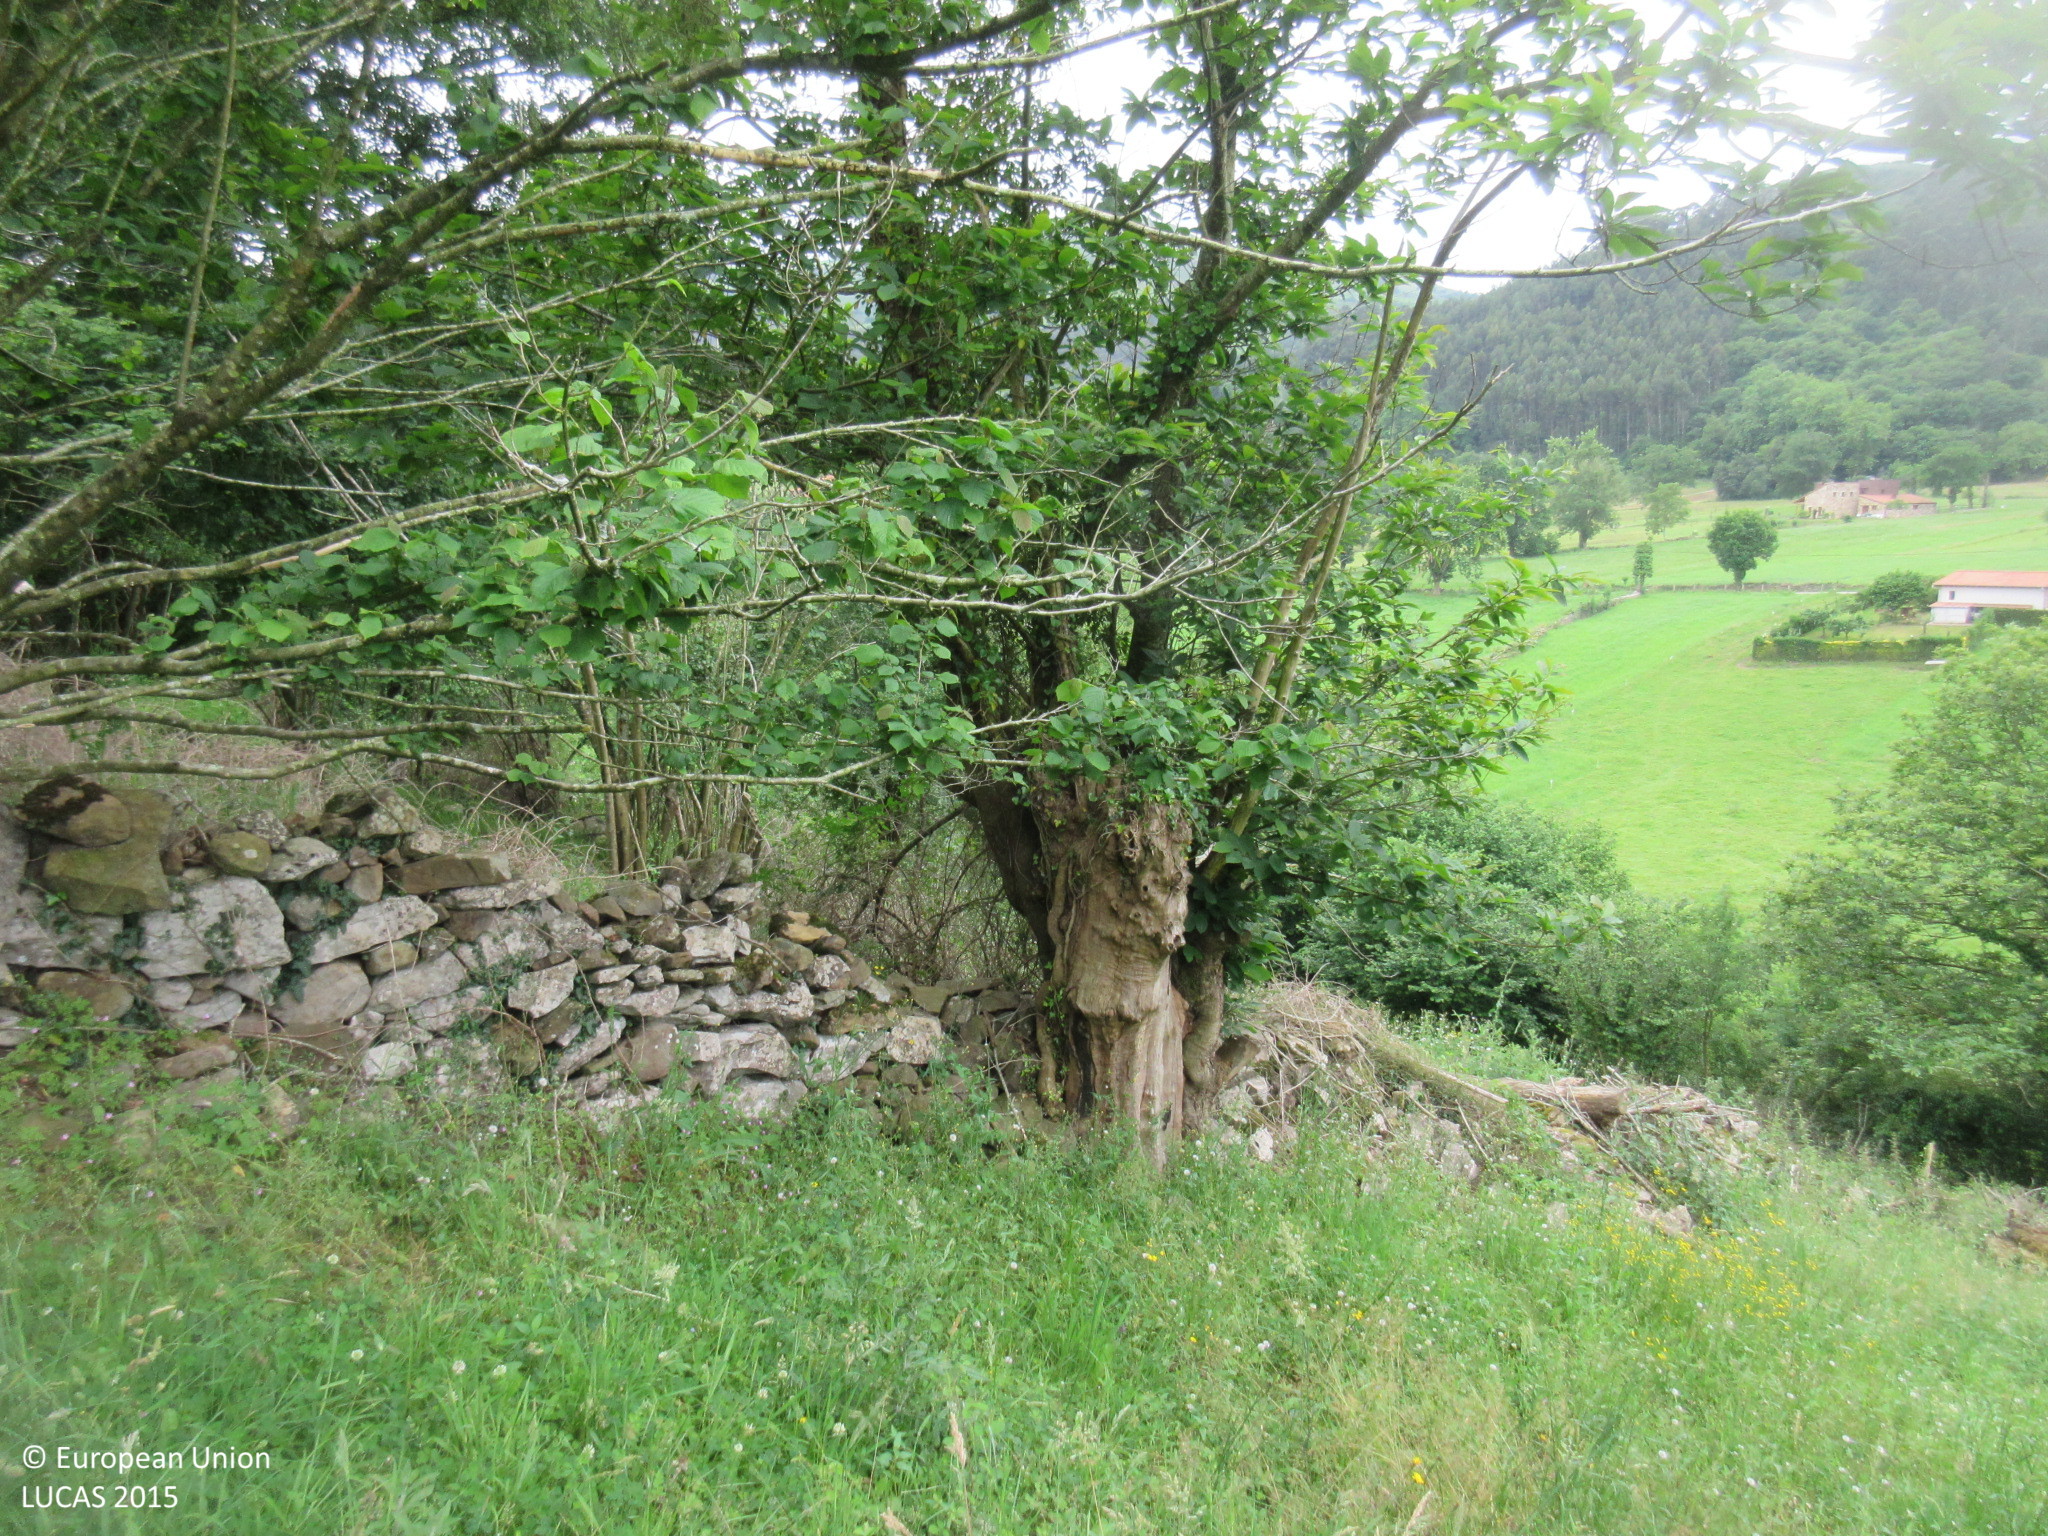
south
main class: Grassland
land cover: Grassland without tree/shrub cover
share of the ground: > 75 %
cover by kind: herbaceous plants 100 %
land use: Agriculture (excluding fallow land and kitchen gardens)
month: June
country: ES
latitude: 43.3583
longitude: -3.6052
